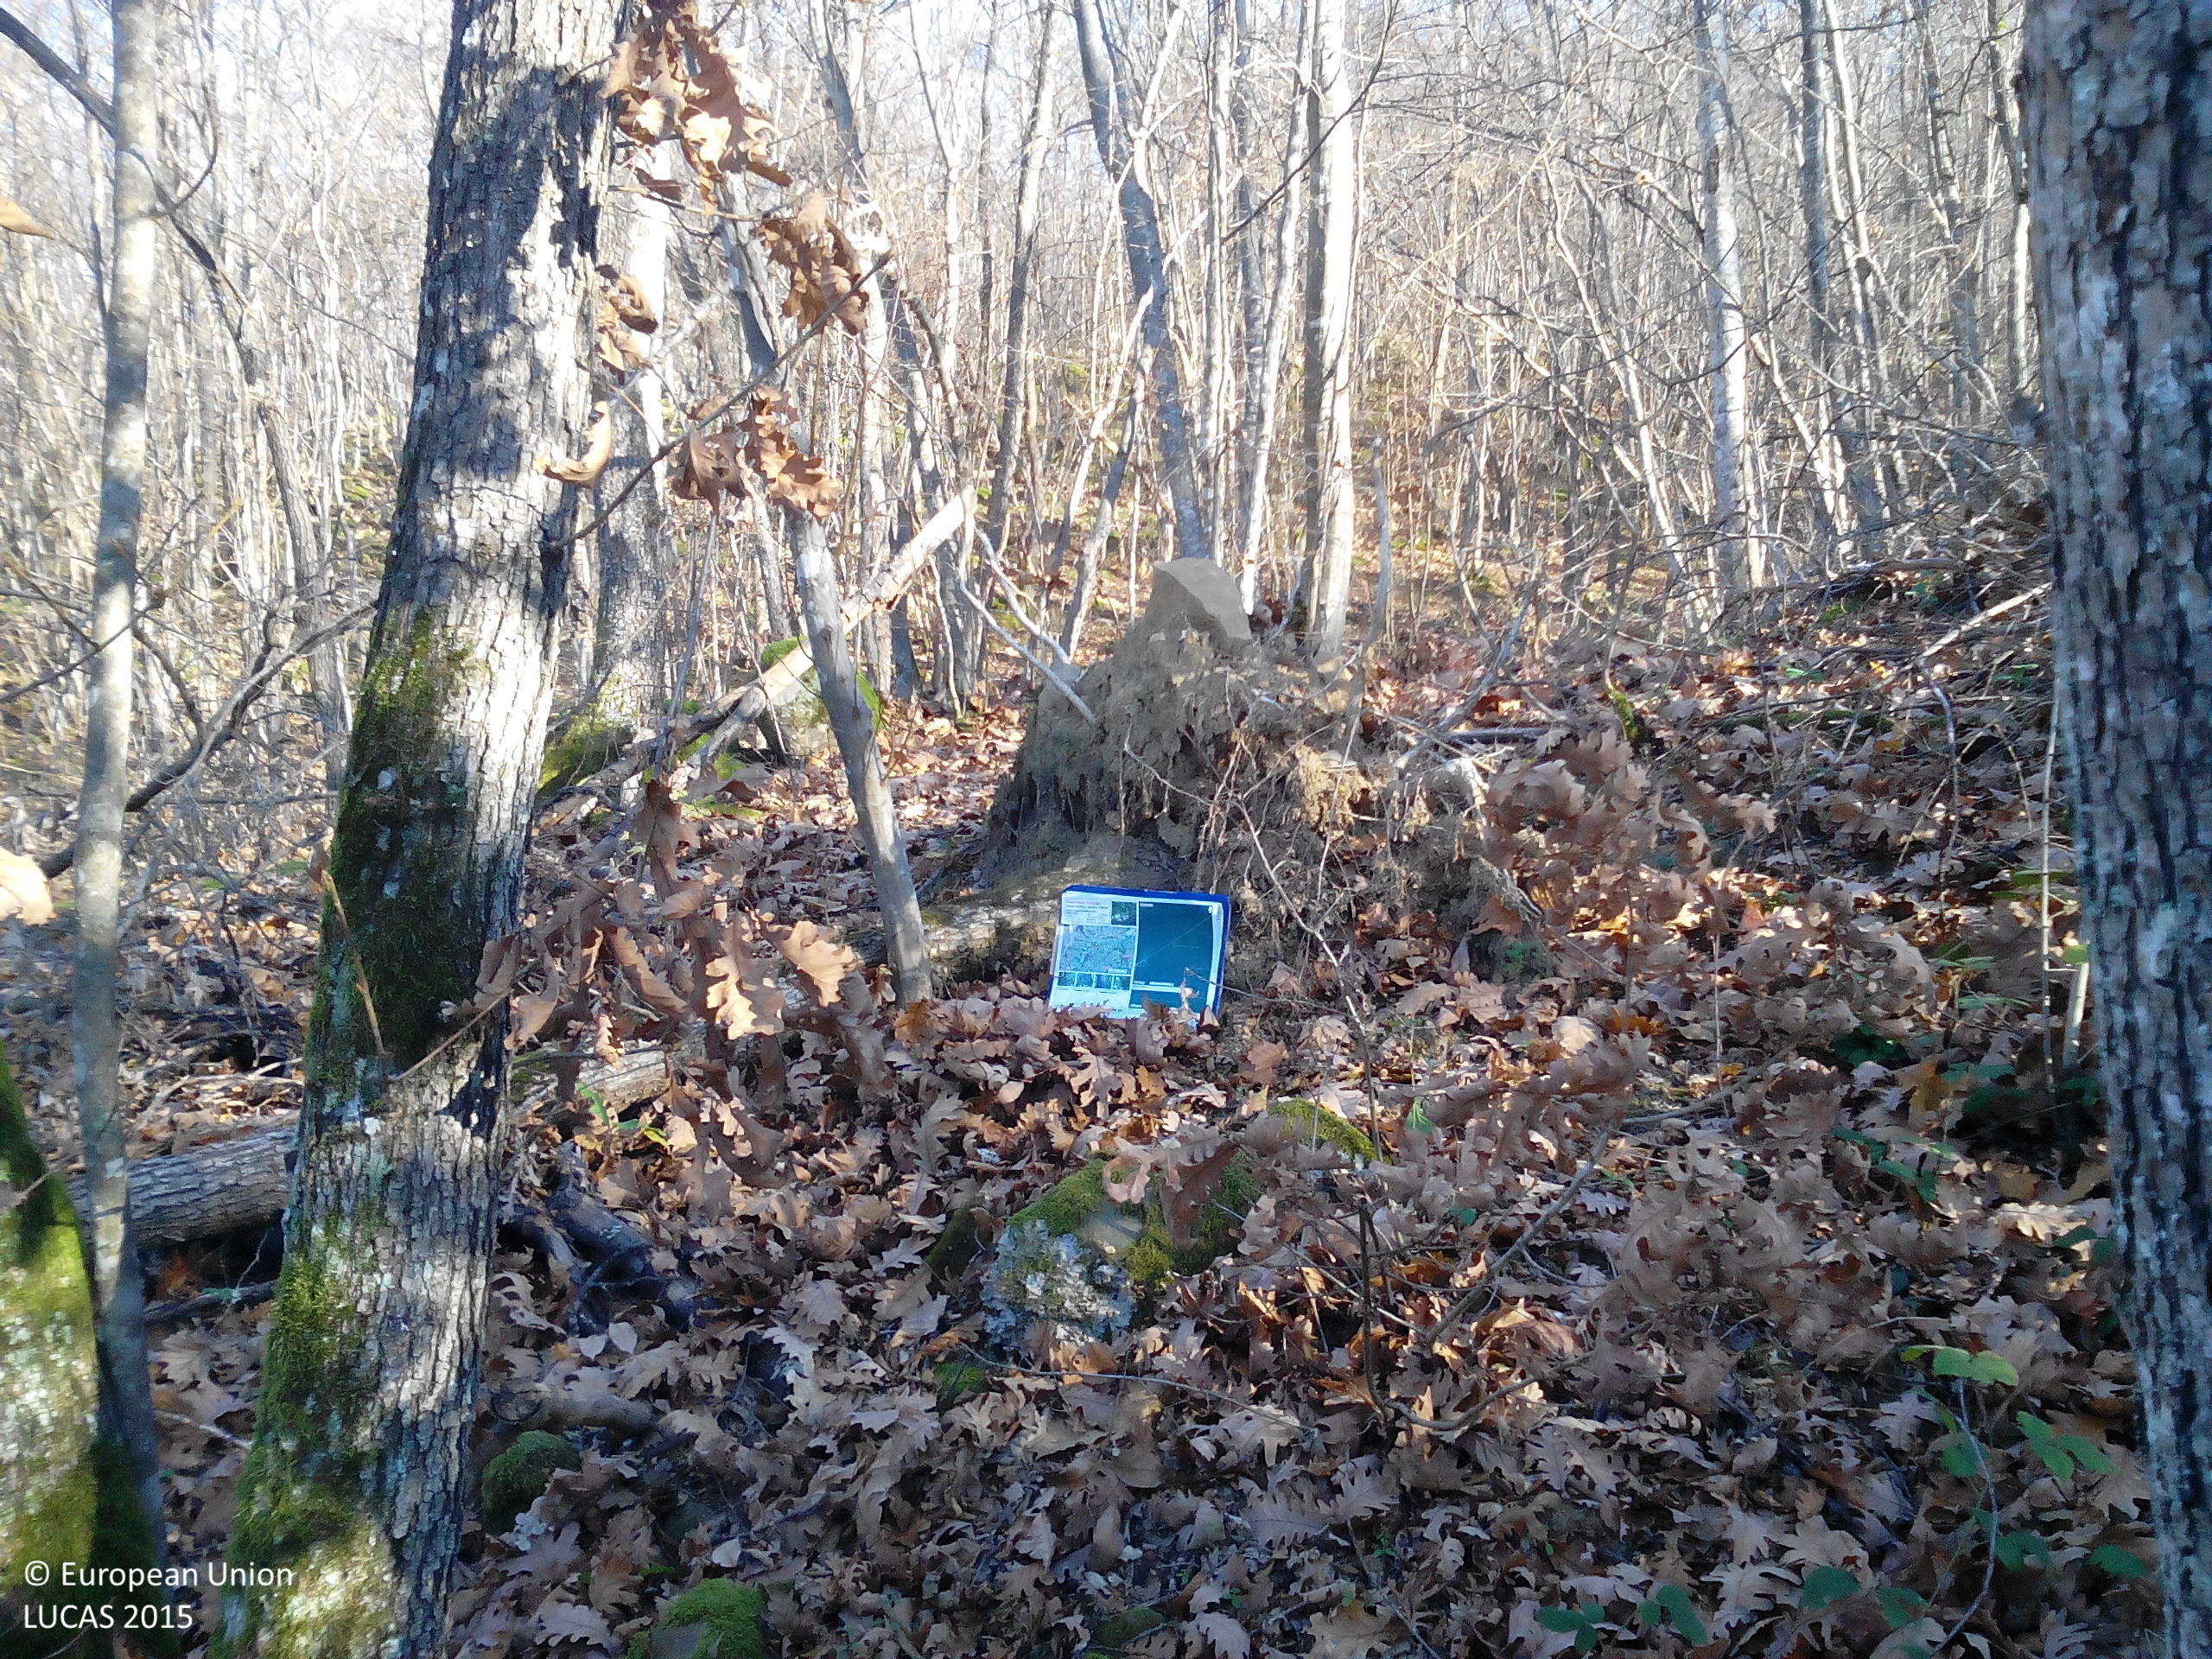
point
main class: Woodland
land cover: Broadleaved woodland
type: mesophytic deciduous forest
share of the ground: > 75 %
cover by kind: broadleaved forest trees 95 %, shrubs 5 %
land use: Forestry
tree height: > 5 m
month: November
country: BG
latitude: 43.0854
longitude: 23.8657
